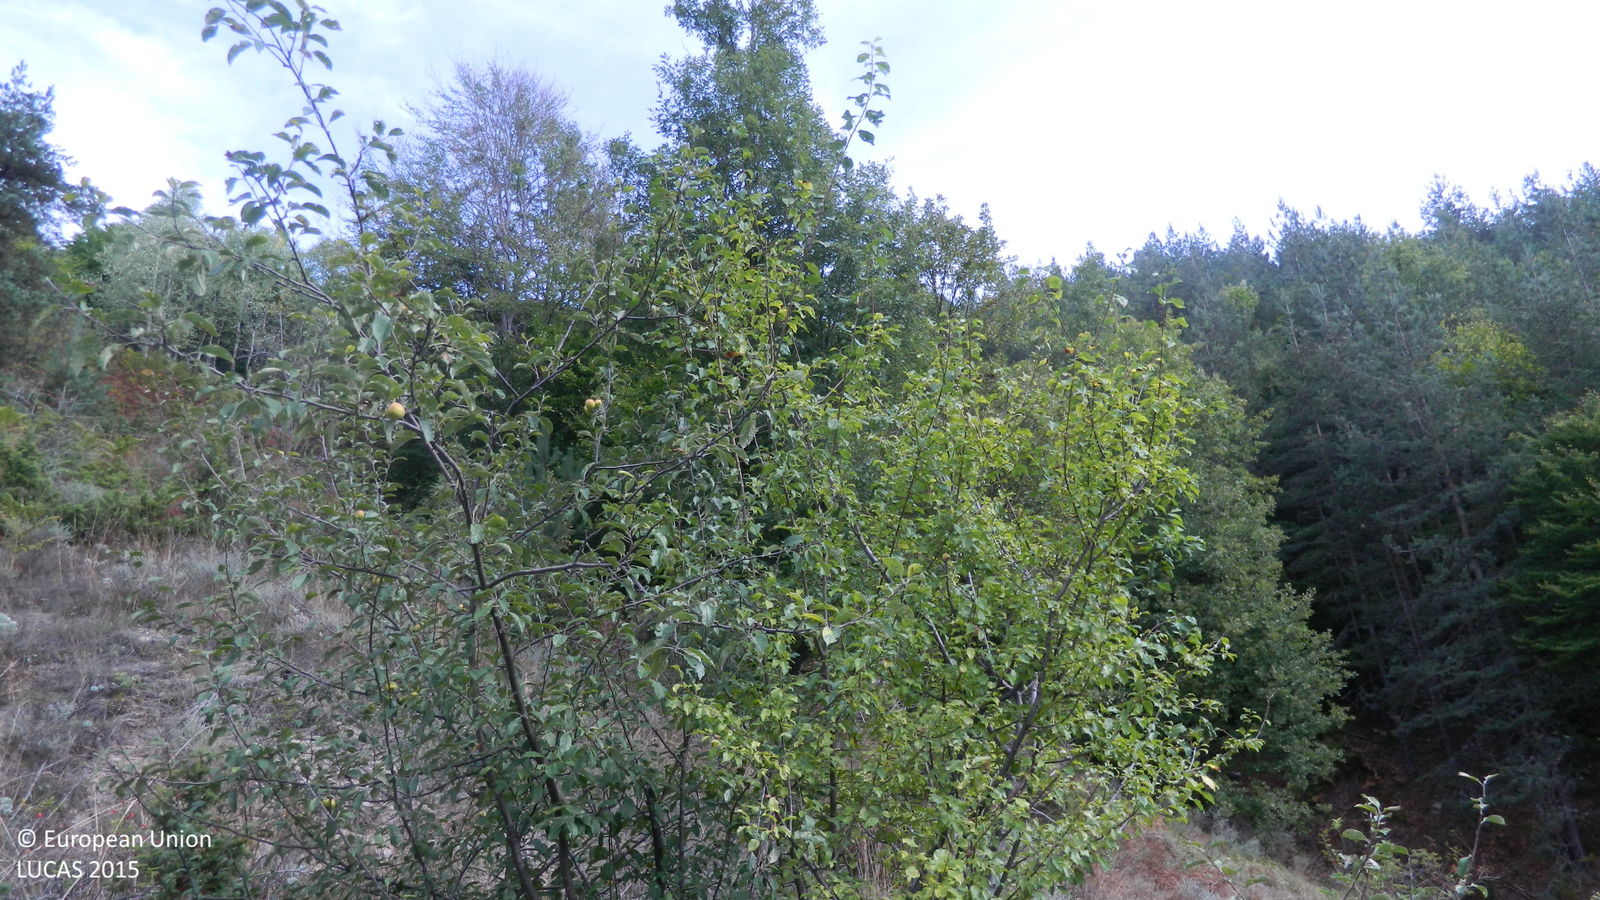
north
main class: Shrubland
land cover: Shrubland with sparse tree cover
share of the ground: > 75 %
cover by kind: herbaceous plants 80 %, shrubs 15 %, coniferous forest trees 5 %
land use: Semi-natural and natural areas not in use
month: October
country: BG
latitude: 41.6050
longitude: 24.8656
